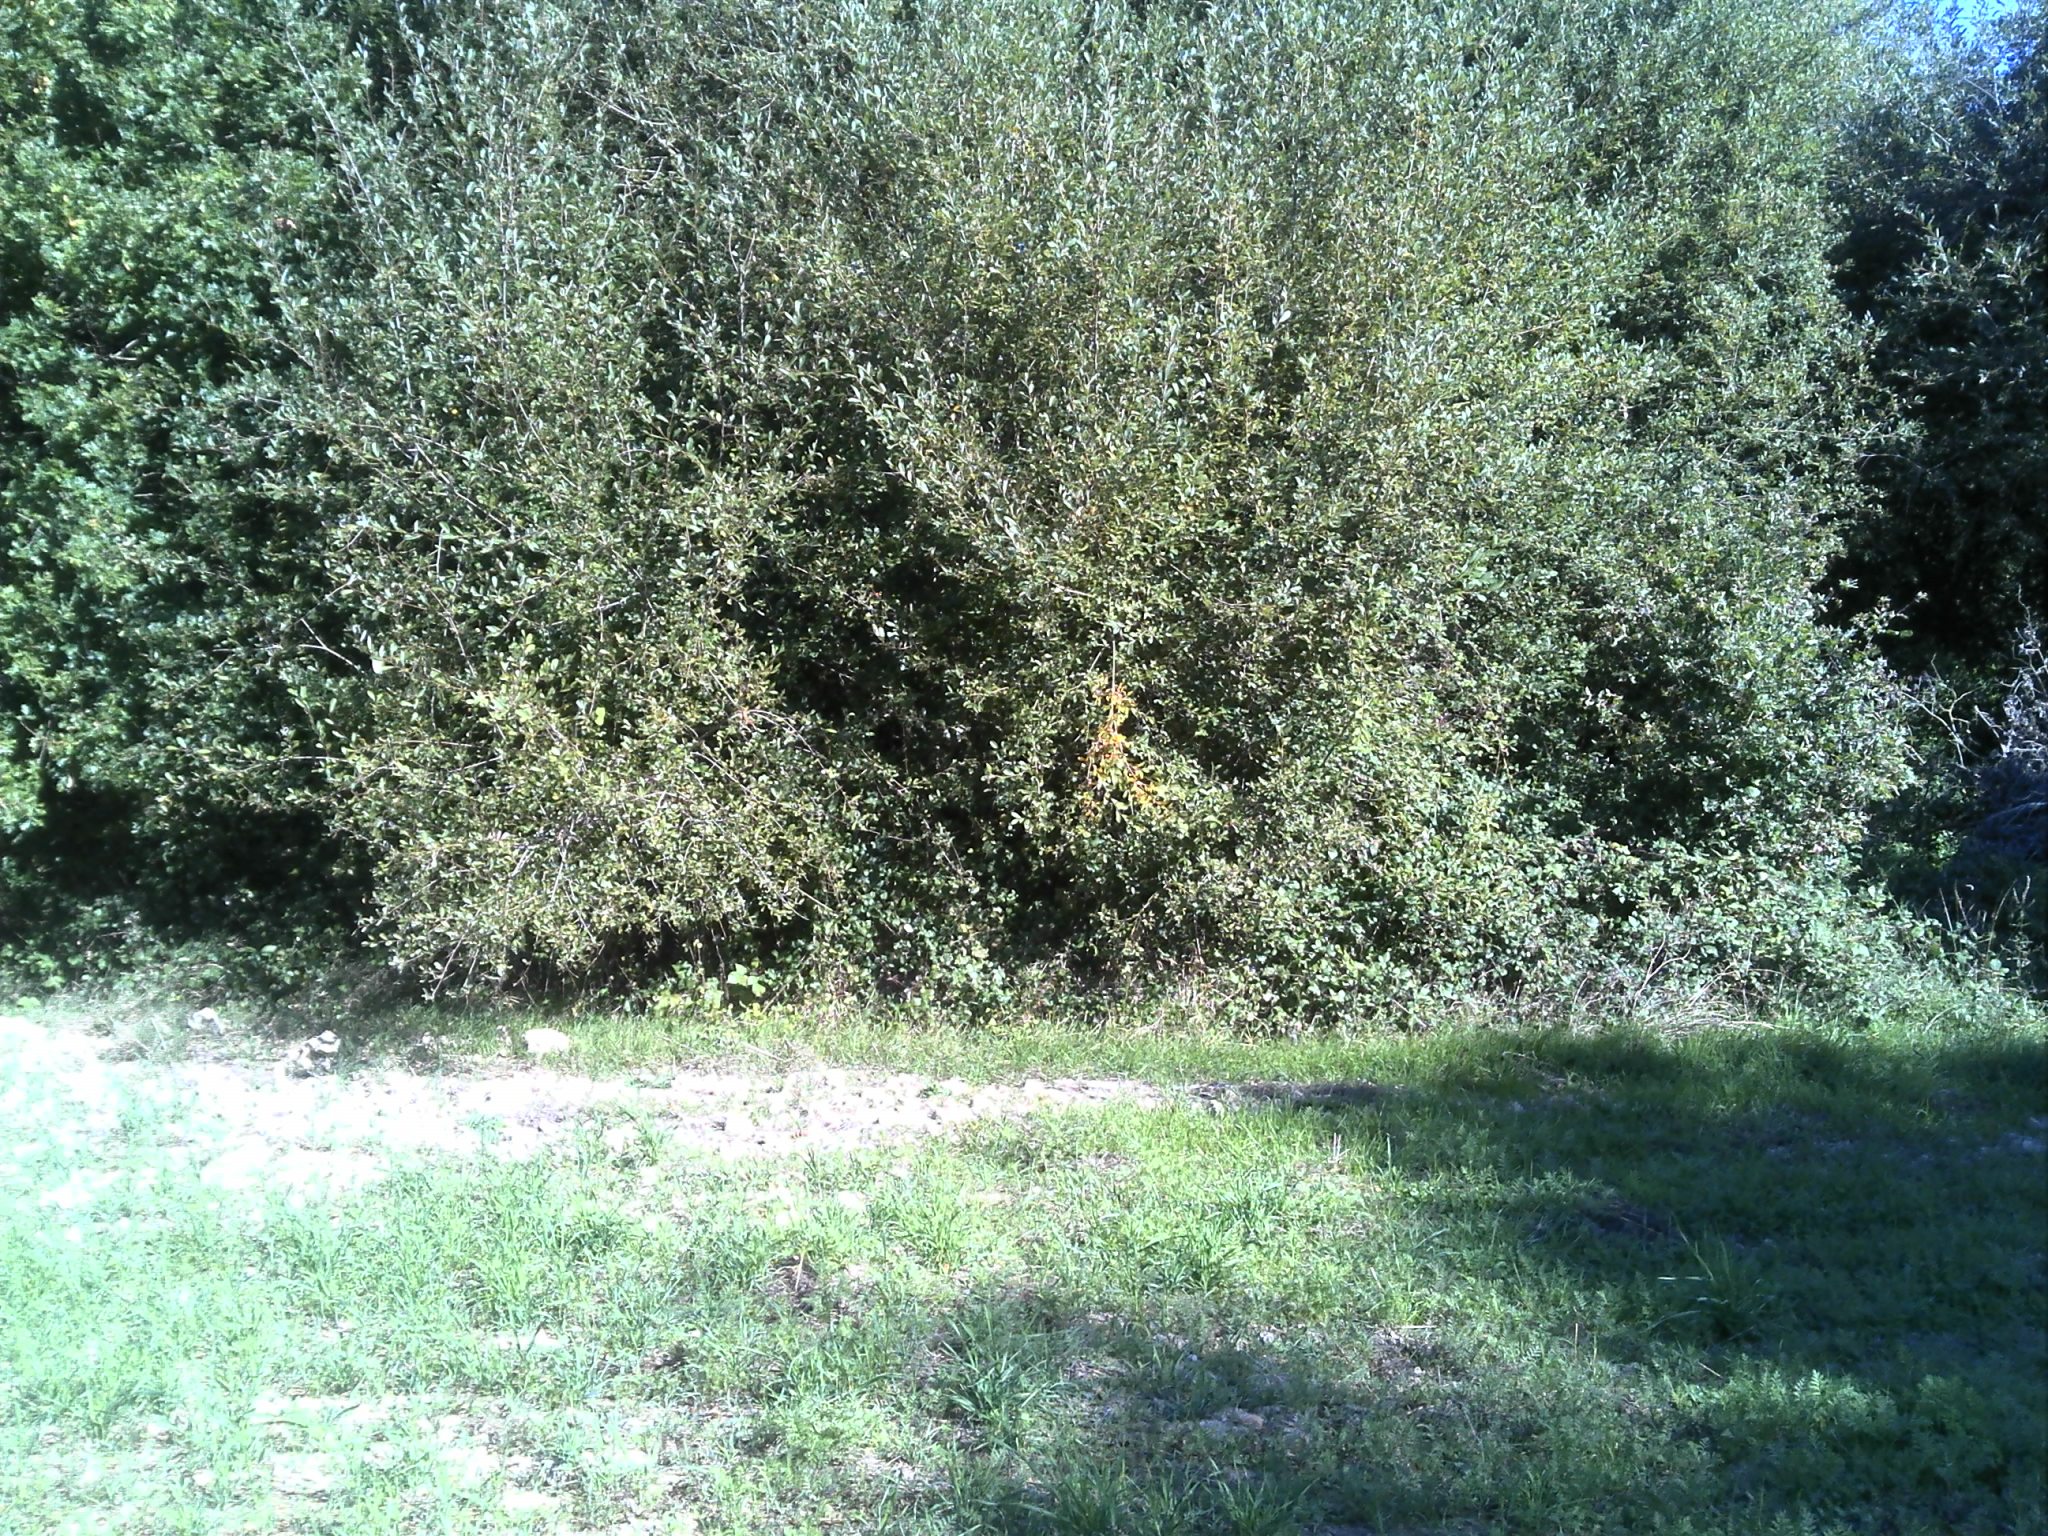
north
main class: Cropland
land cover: Other leguminous and mixtures for fodder
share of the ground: 50 - 75 %
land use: Agriculture (excluding fallow land and kitchen gardens)
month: October
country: FR
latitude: 47.6537
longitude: -0.9947
